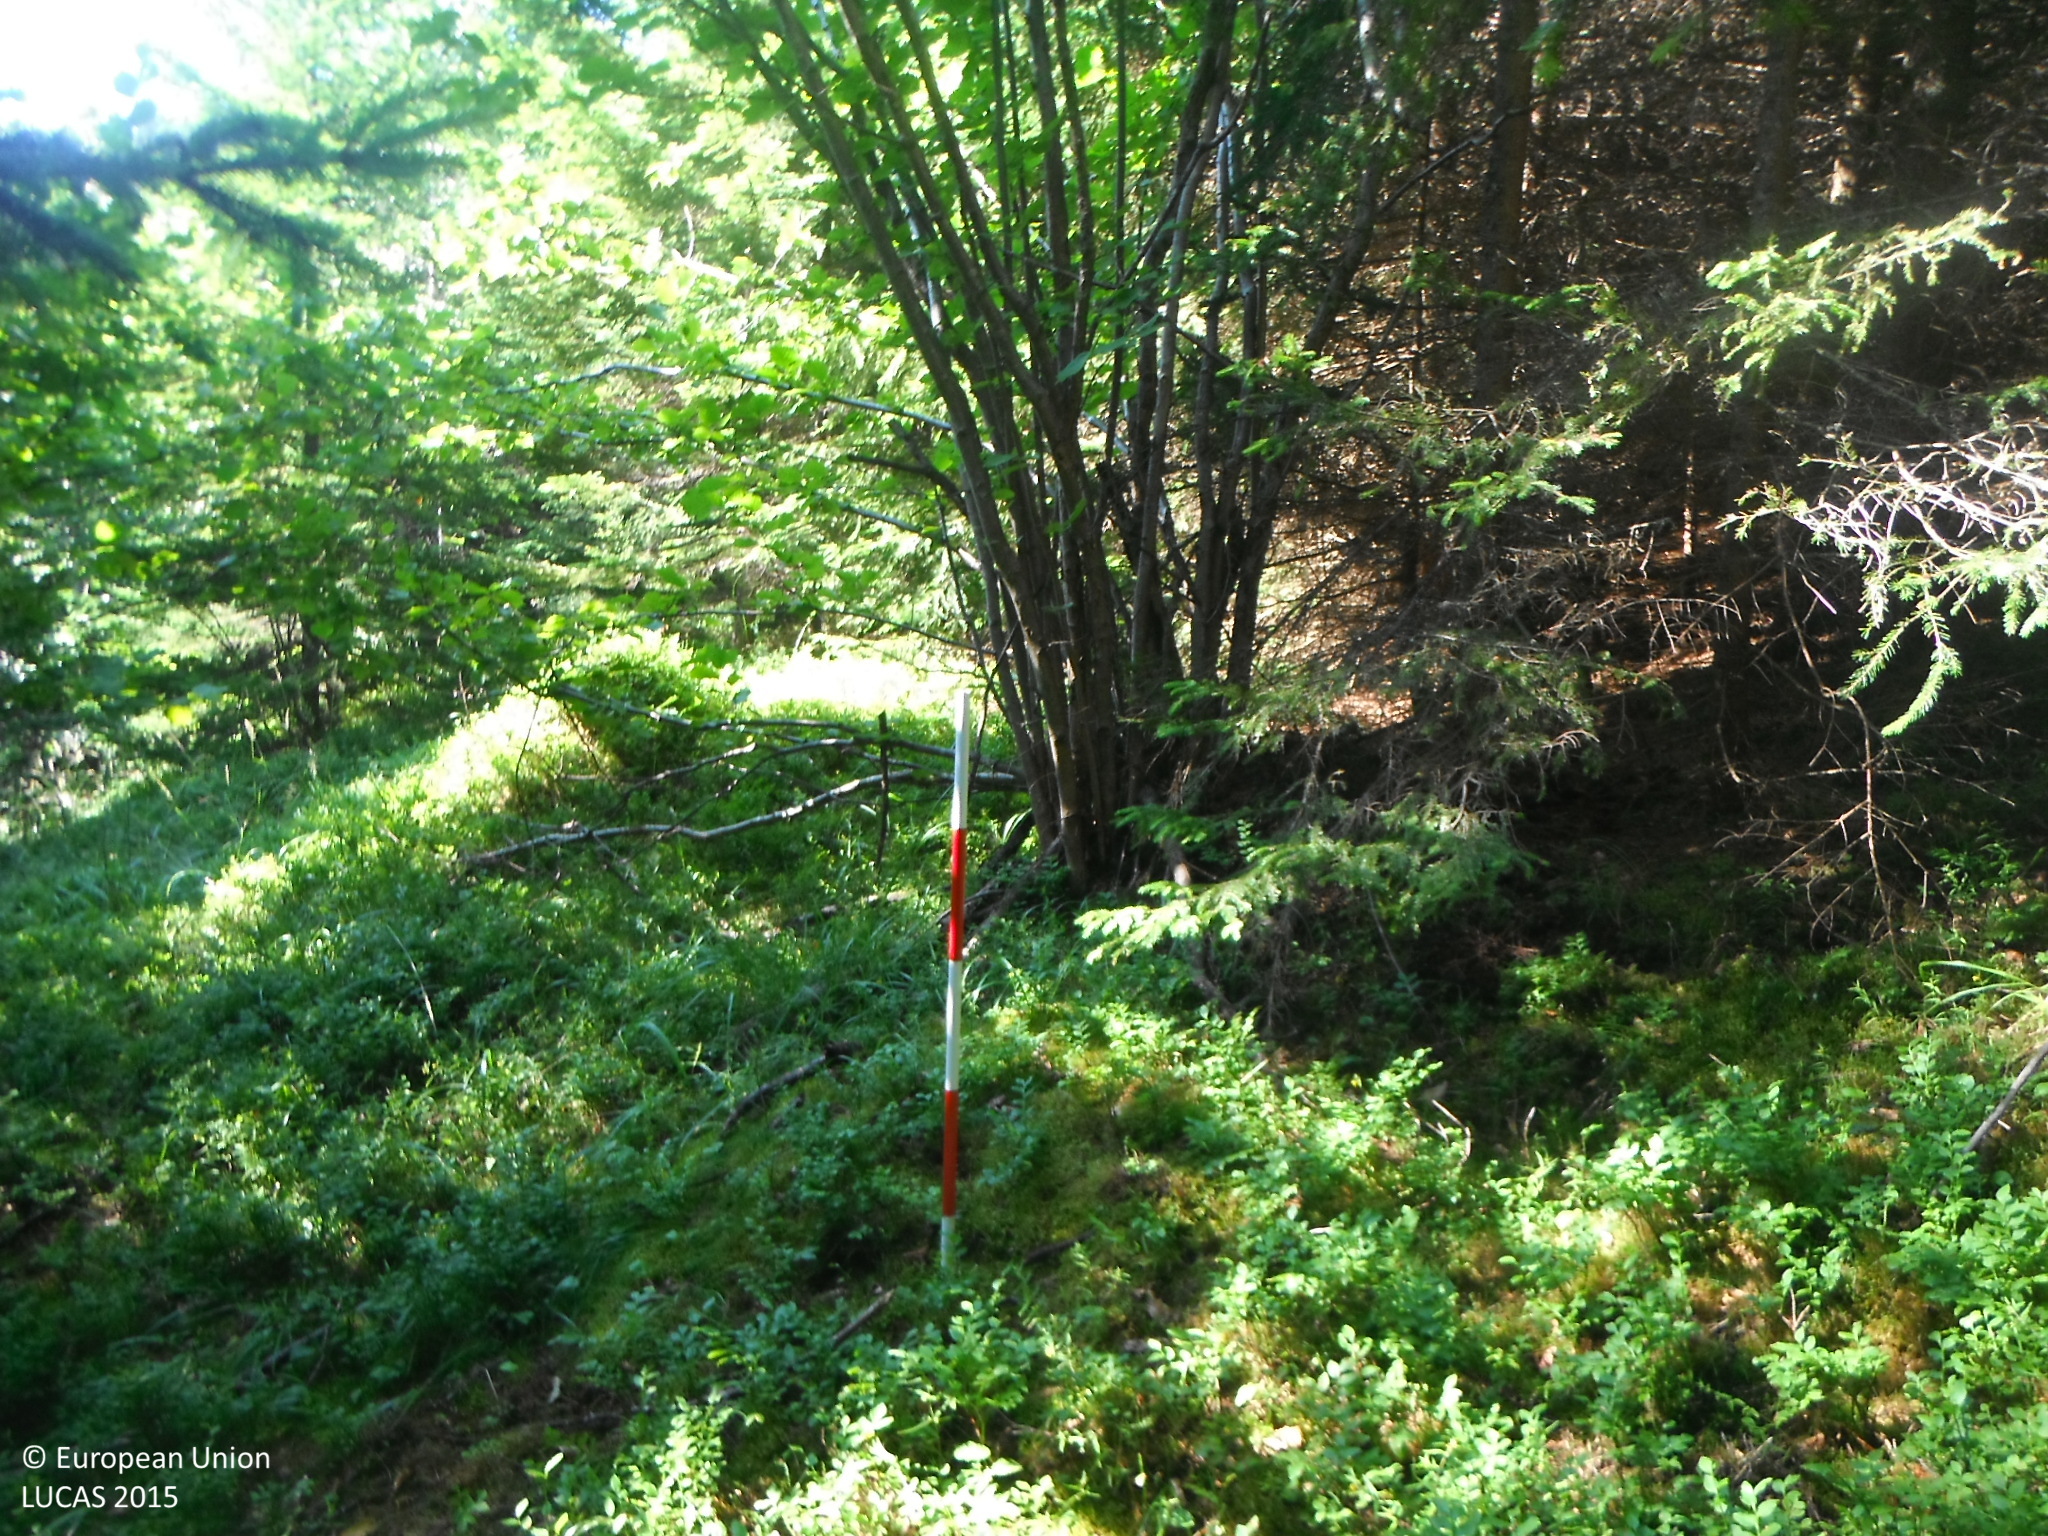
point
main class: Woodland
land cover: Spruce dominated mixed woodland
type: hemiboreal forest and nemoral coniferous forest and mixed broadleaved-coniferous forest
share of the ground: > 75 %
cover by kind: coniferous forest trees 60 %, broadleaved forest trees 40 %
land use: Forestry
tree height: > 5 m
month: July
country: SK
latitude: 48.9228
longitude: 20.2554
